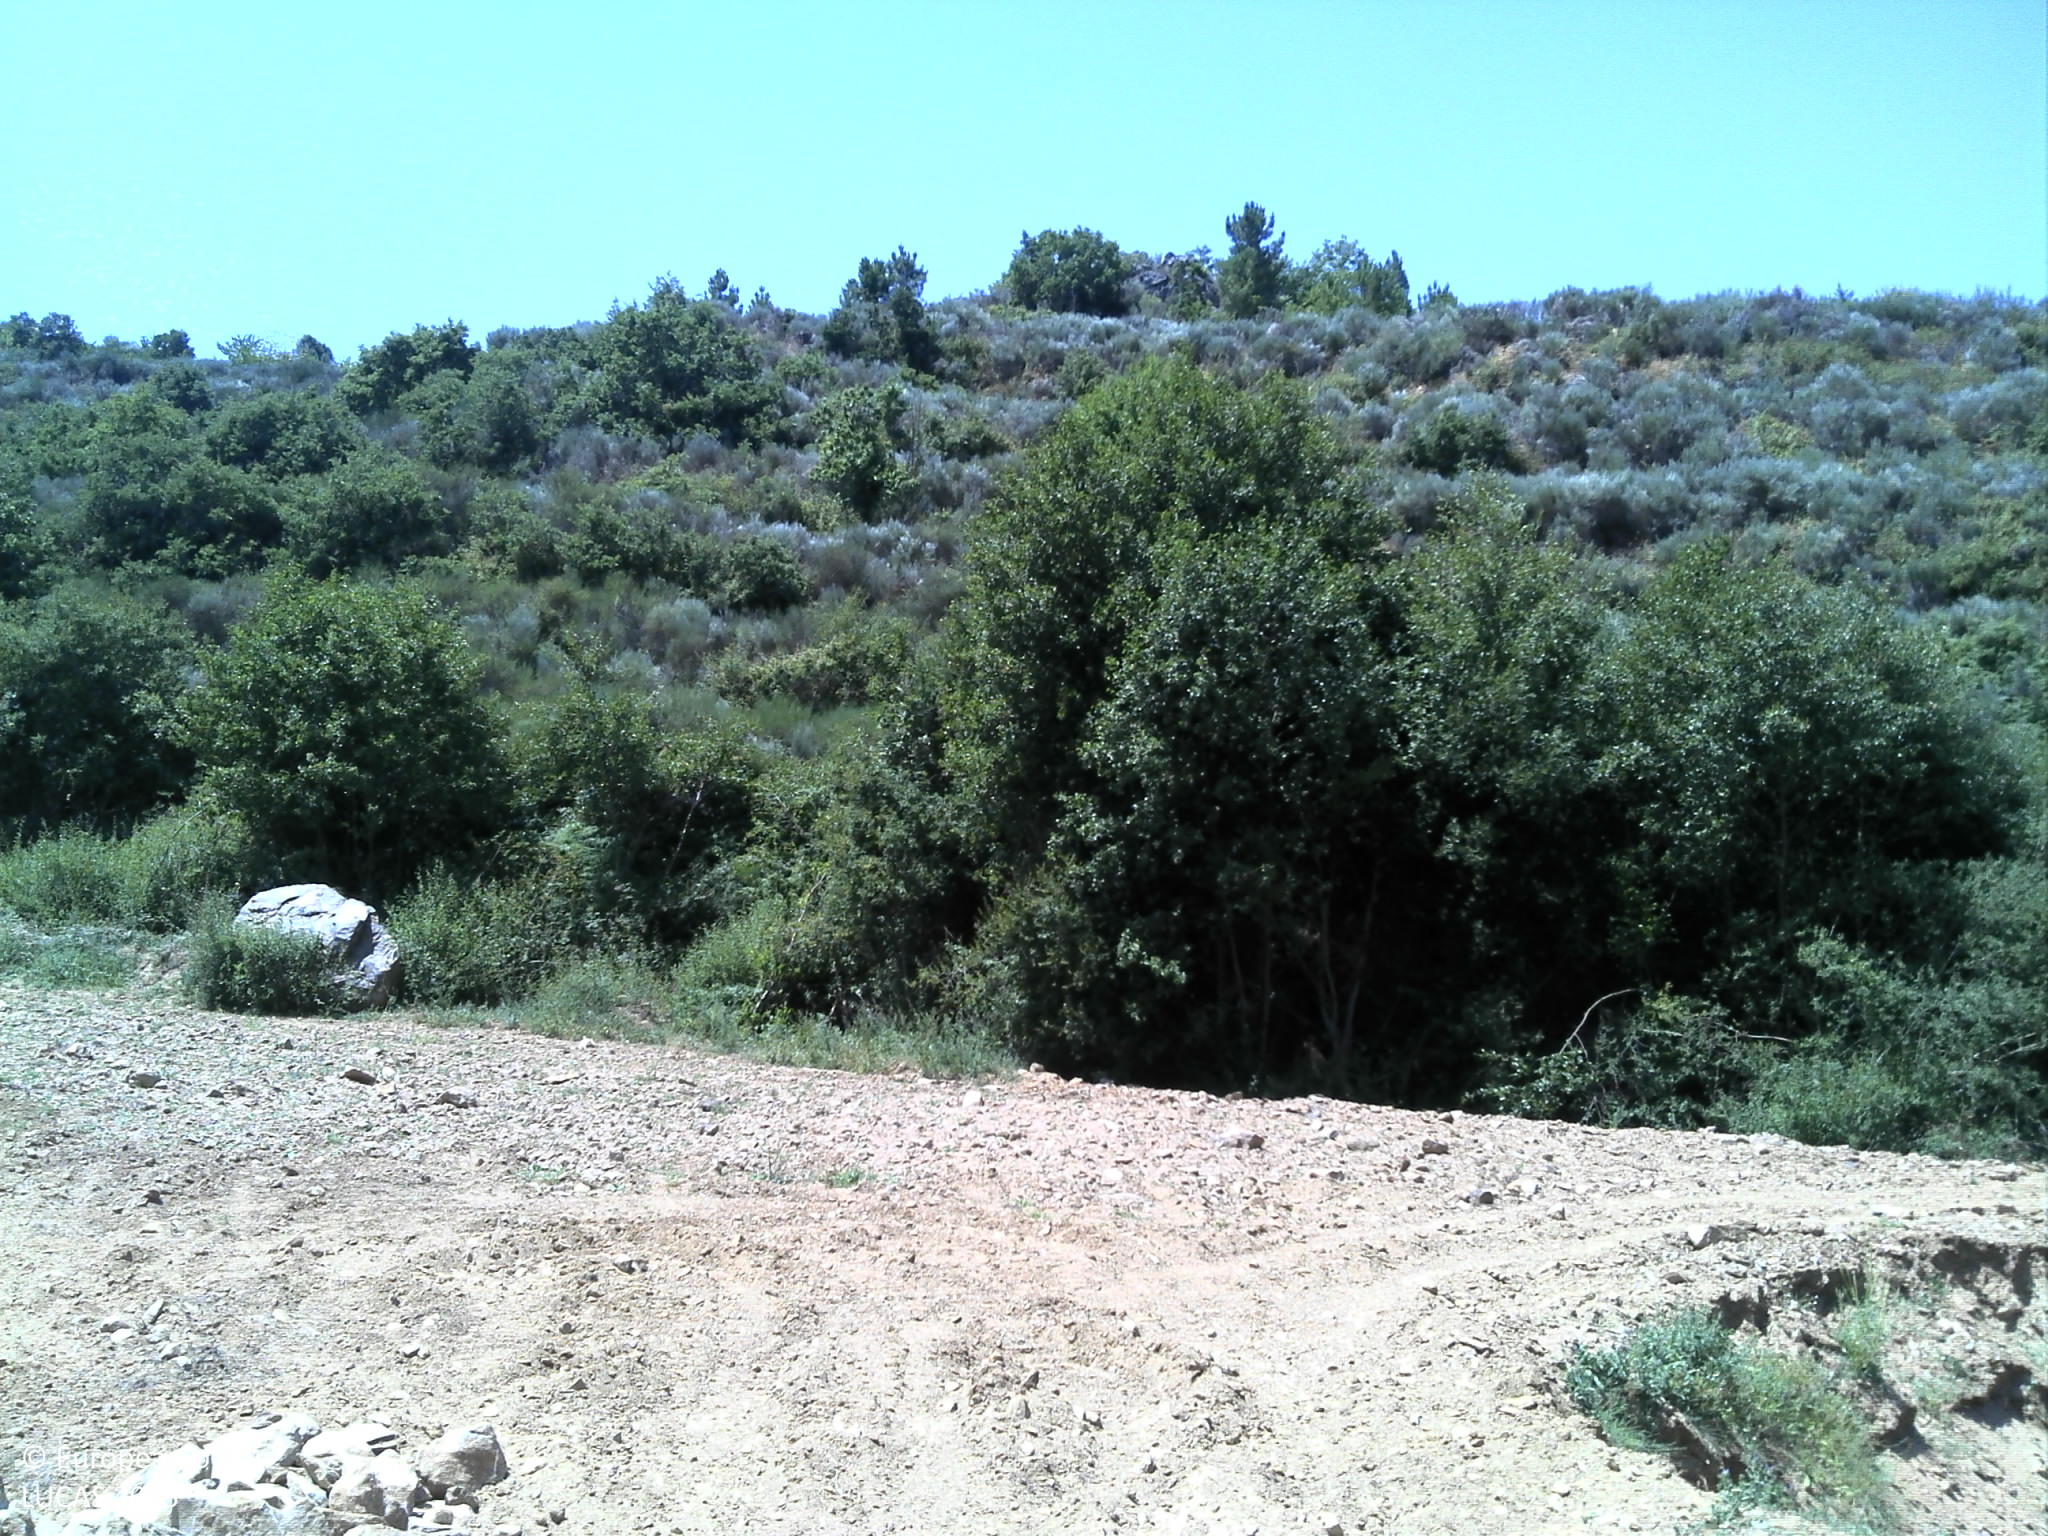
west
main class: Grassland
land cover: Spontaneously vegetated surfaces
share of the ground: < 10 %
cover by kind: unconsolidated bare surface 90 %, herbaceous plants 10 %
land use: Fallow land
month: July
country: PT
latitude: 41.0592
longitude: -7.4073
